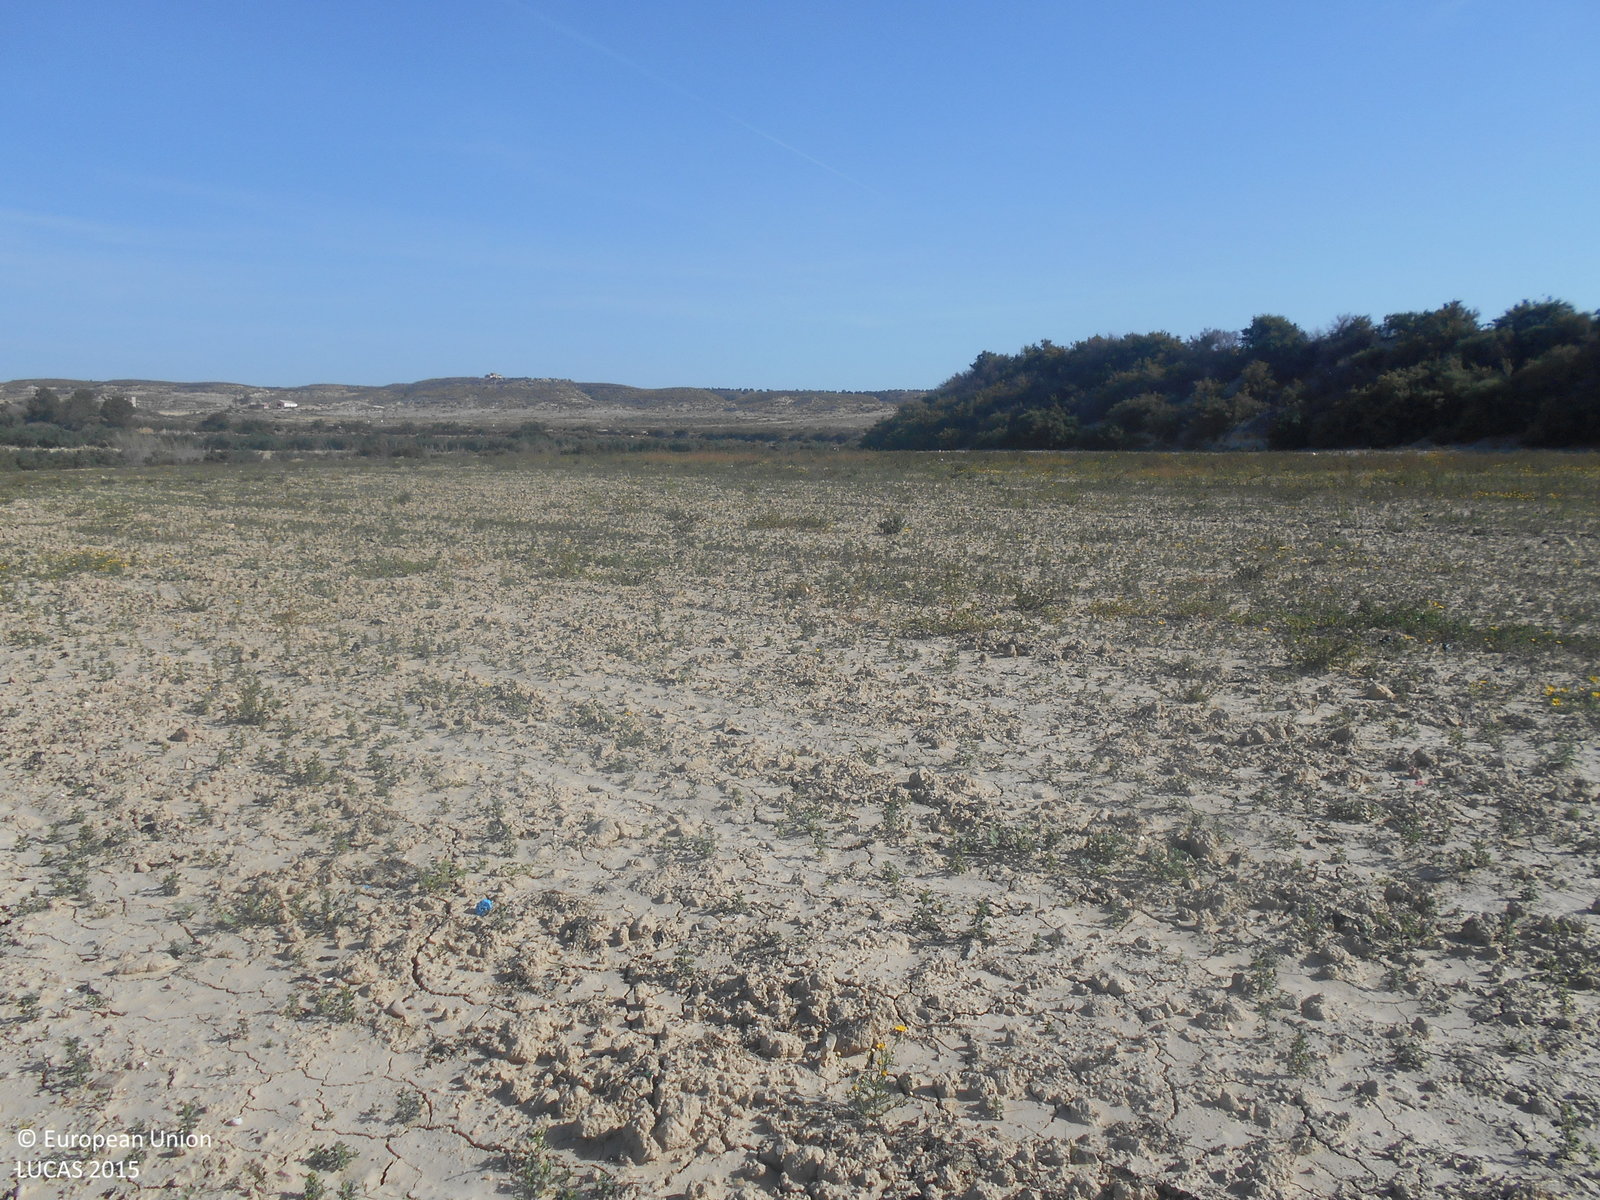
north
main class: Grassland
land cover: Spontaneously vegetated surfaces
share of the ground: 10 - 25 %
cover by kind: unconsolidated bare surface 80 %, herbaceous plants 20 %
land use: Fallow land
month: May
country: ES
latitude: 37.6638
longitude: -1.3967
